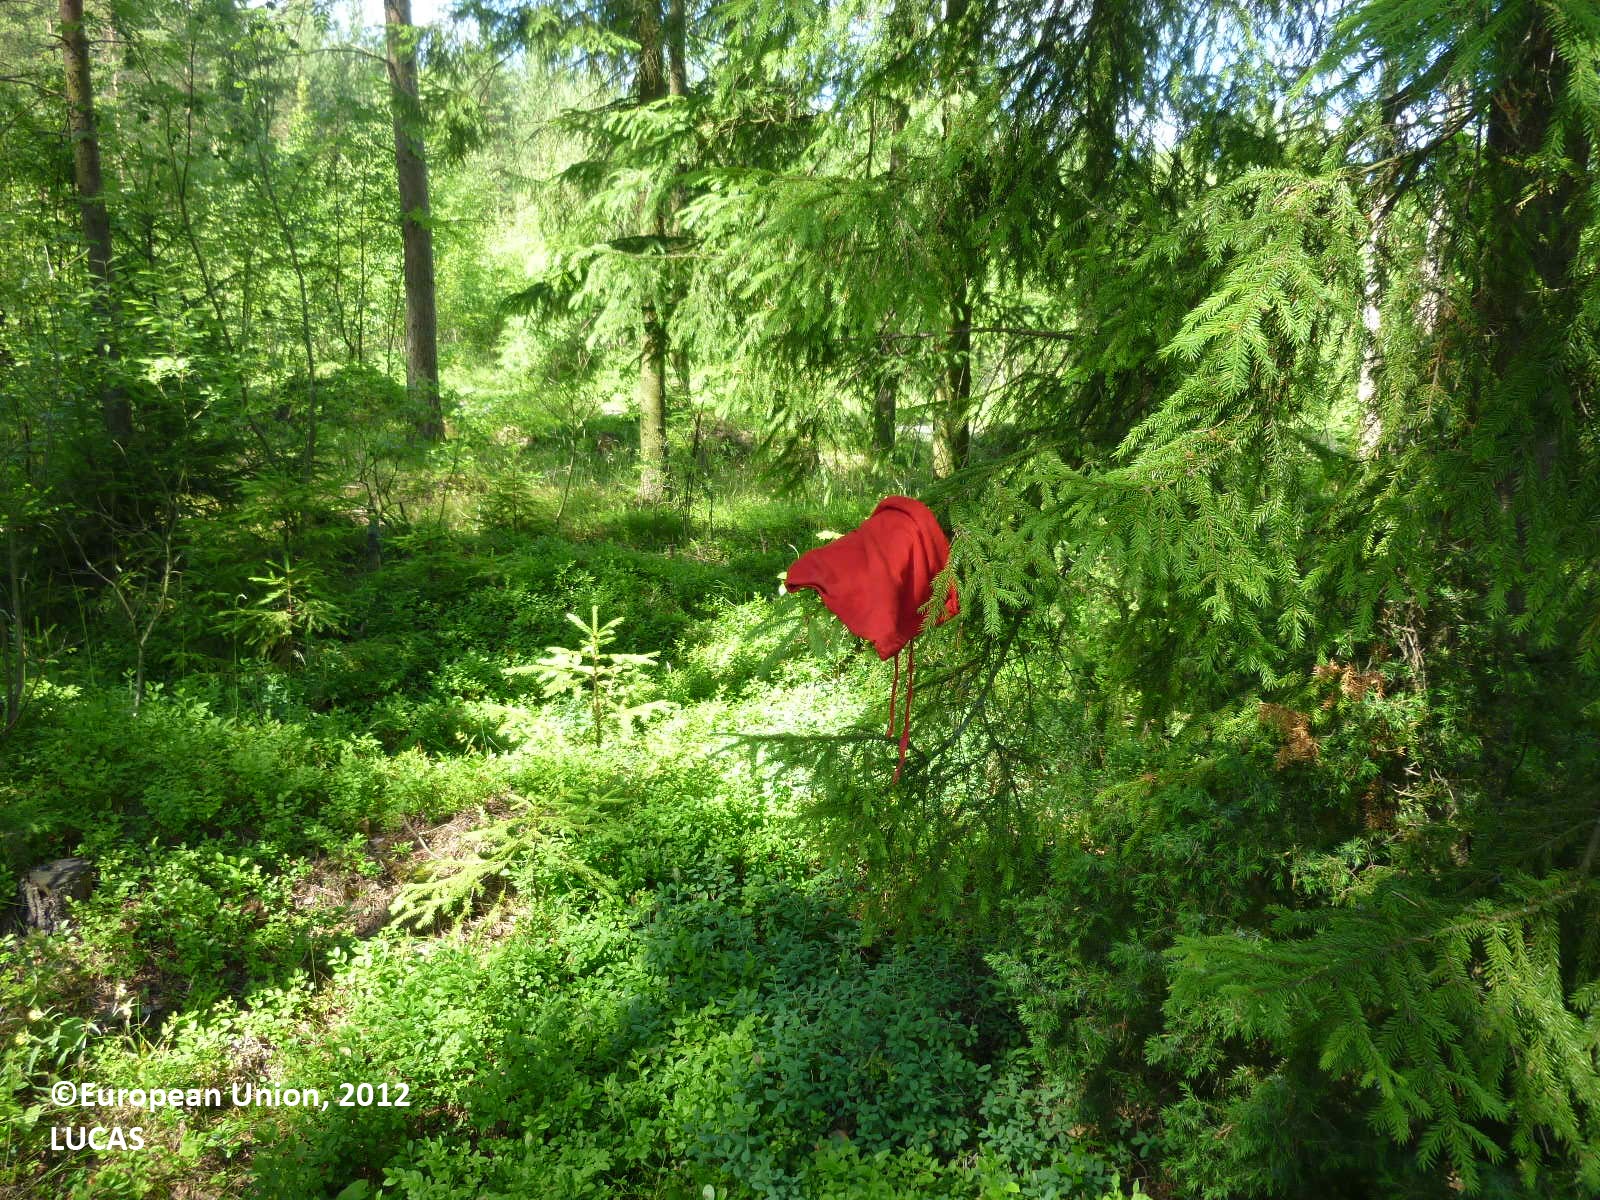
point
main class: Woodland
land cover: Other coniferous woodland
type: boreal forest
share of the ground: > 75 %
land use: Forestry
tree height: > 5 m
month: July
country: FI
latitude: 61.3533
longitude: 22.1199
